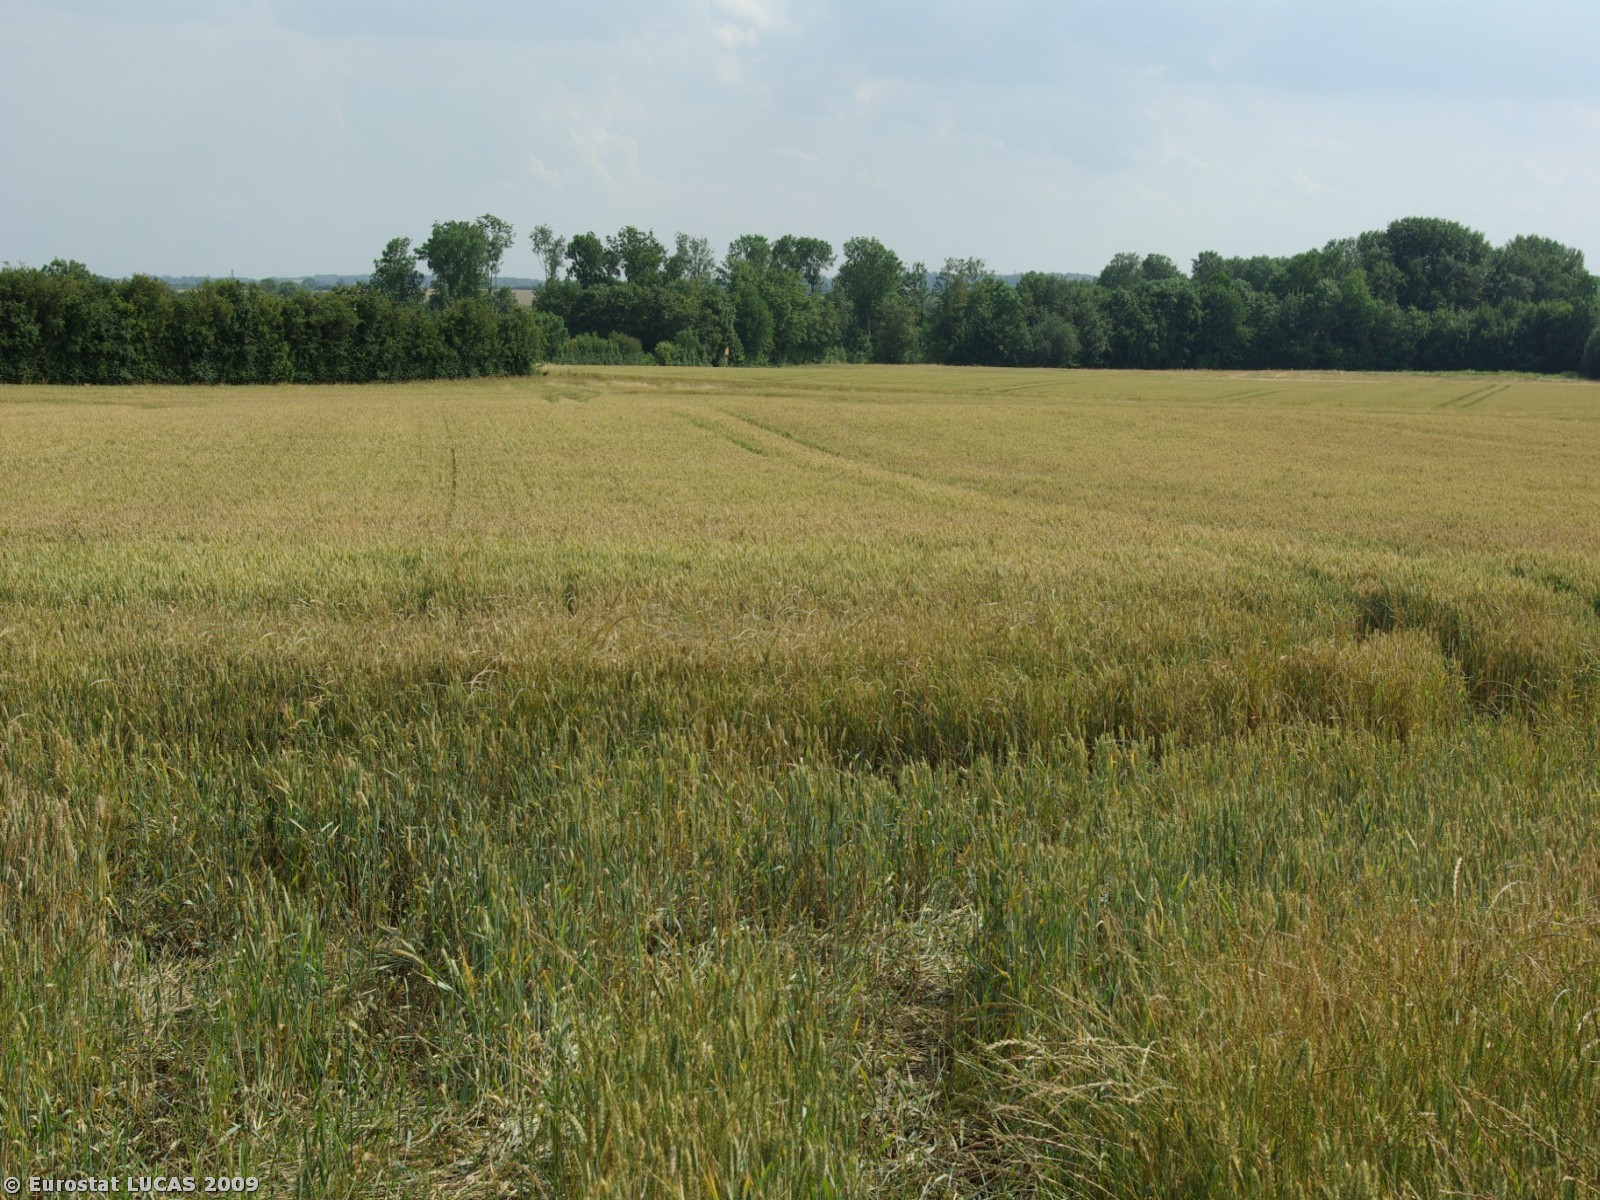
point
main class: Cropland
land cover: Common wheat
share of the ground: > 75 %
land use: Agriculture (excluding fallow land and kitchen gardens)
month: July
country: DK
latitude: 54.9834
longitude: 9.8595
